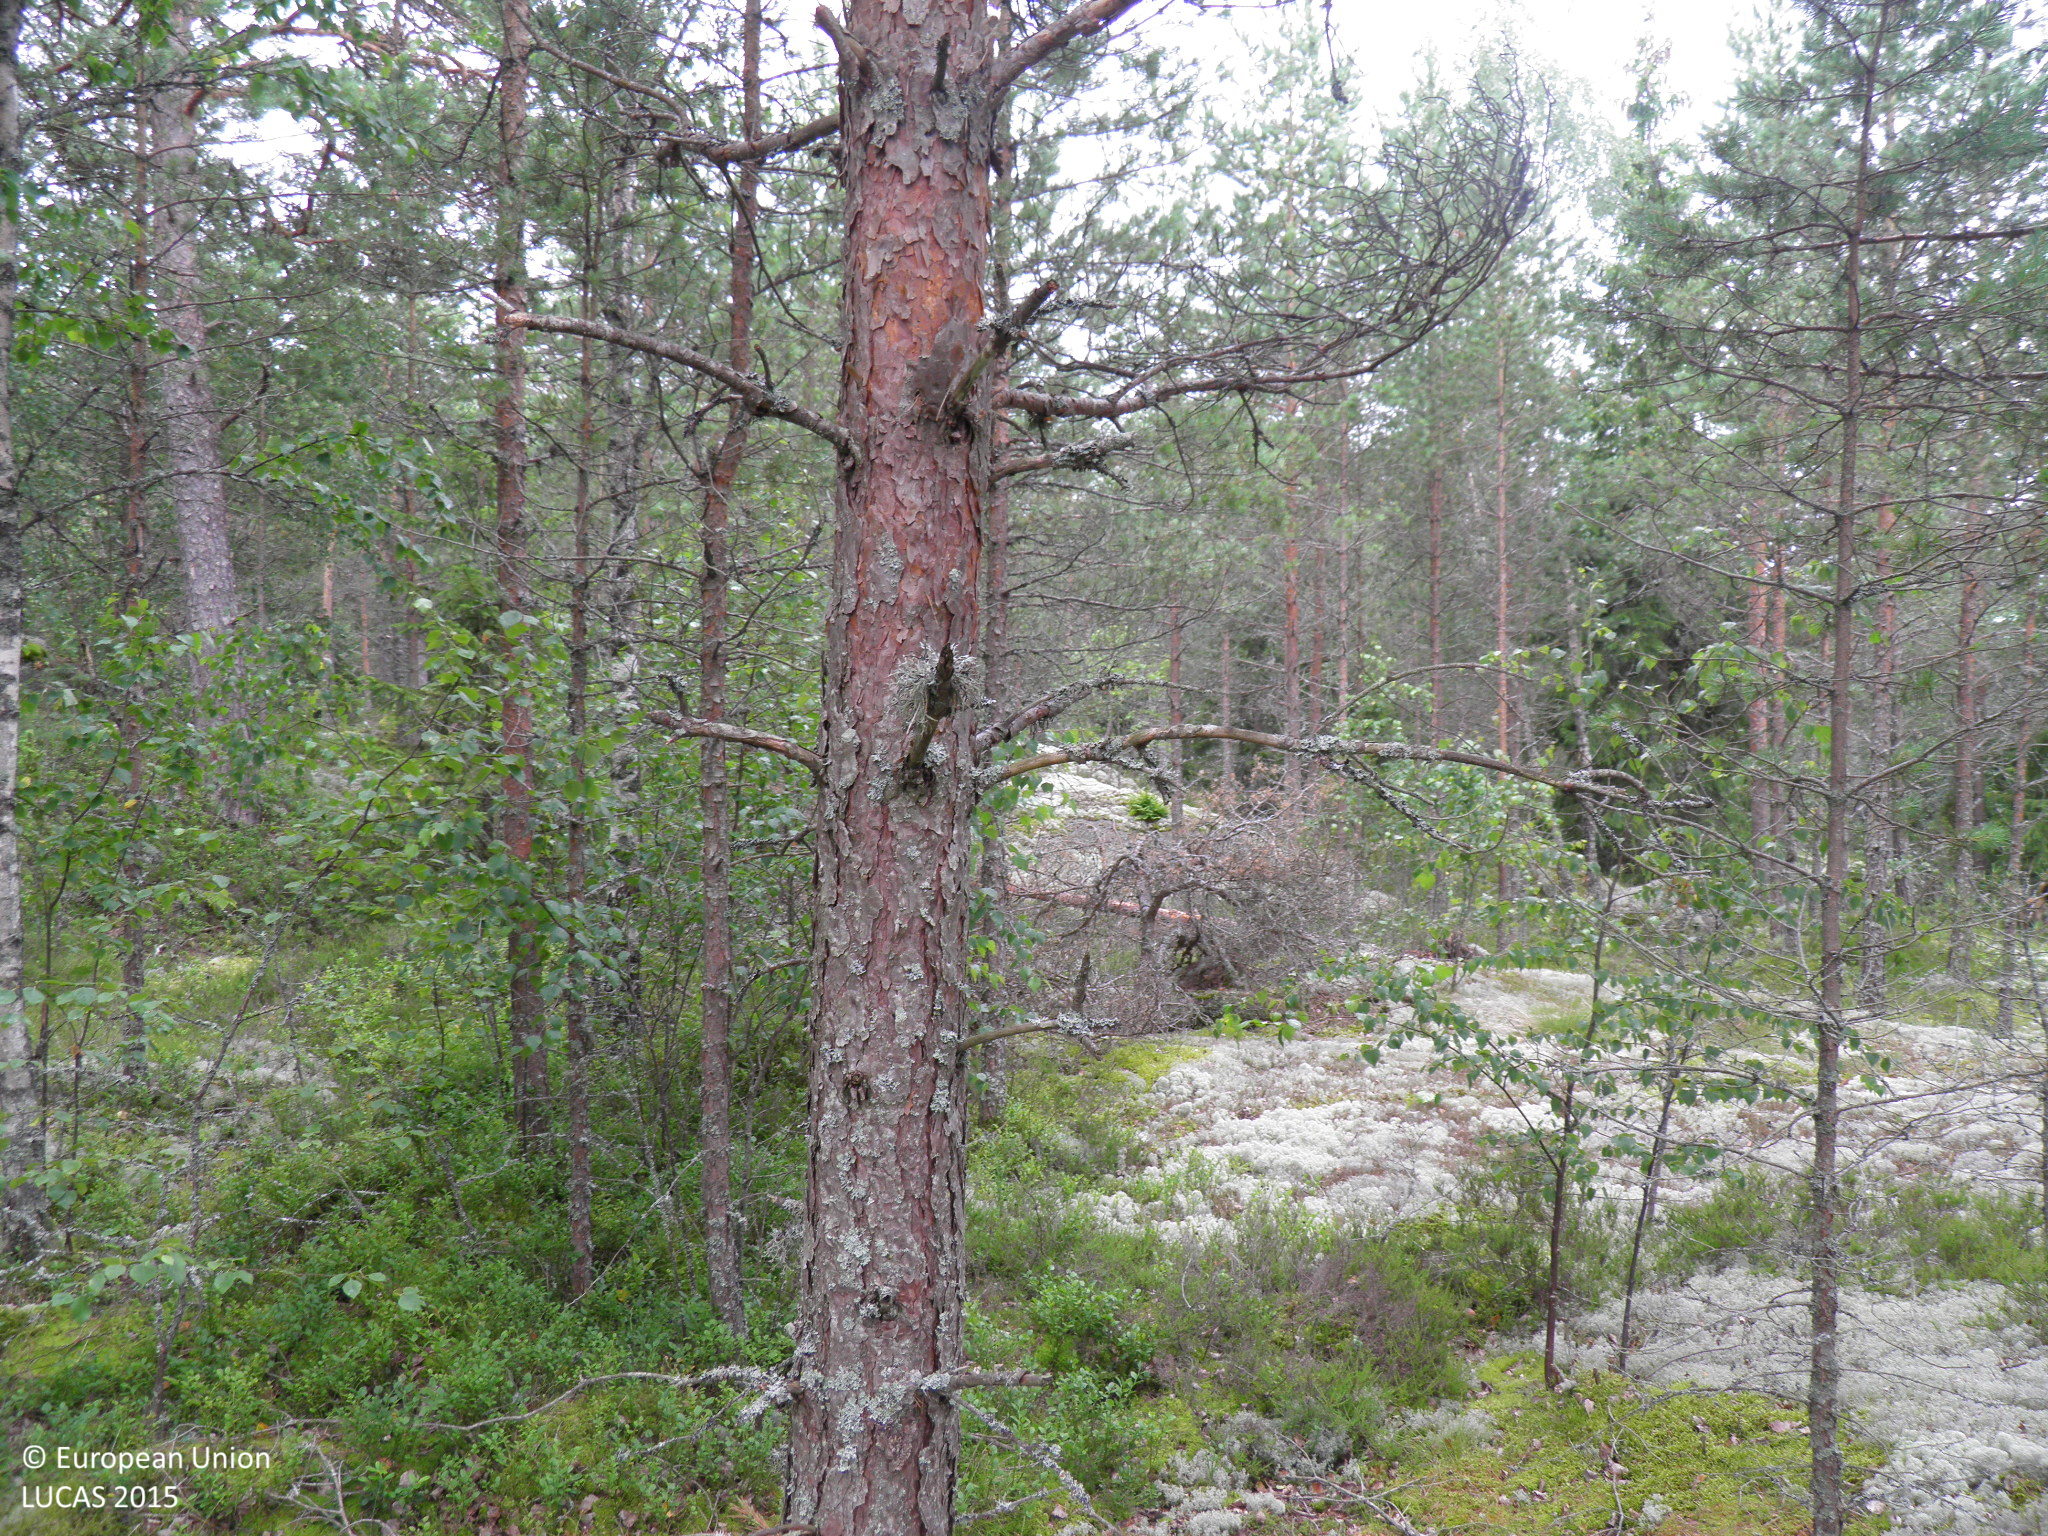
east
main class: Woodland
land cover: Pine dominated coniferous woodland
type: hemiboreal forest and nemoral coniferous forest and mixed broadleaved-coniferous forest
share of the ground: 50 - 75 %
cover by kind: coniferous forest trees 40 %, shrubs 25 %, lichens and mosses 20 %, broadleaved forest trees 10 %, consolidated bare surface 5 %
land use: Forestry
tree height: > 5 m
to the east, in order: Pine dominated coniferous woodland; Pine dominated mixed woodland
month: July
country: FI
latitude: 60.6808
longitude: 21.6461
